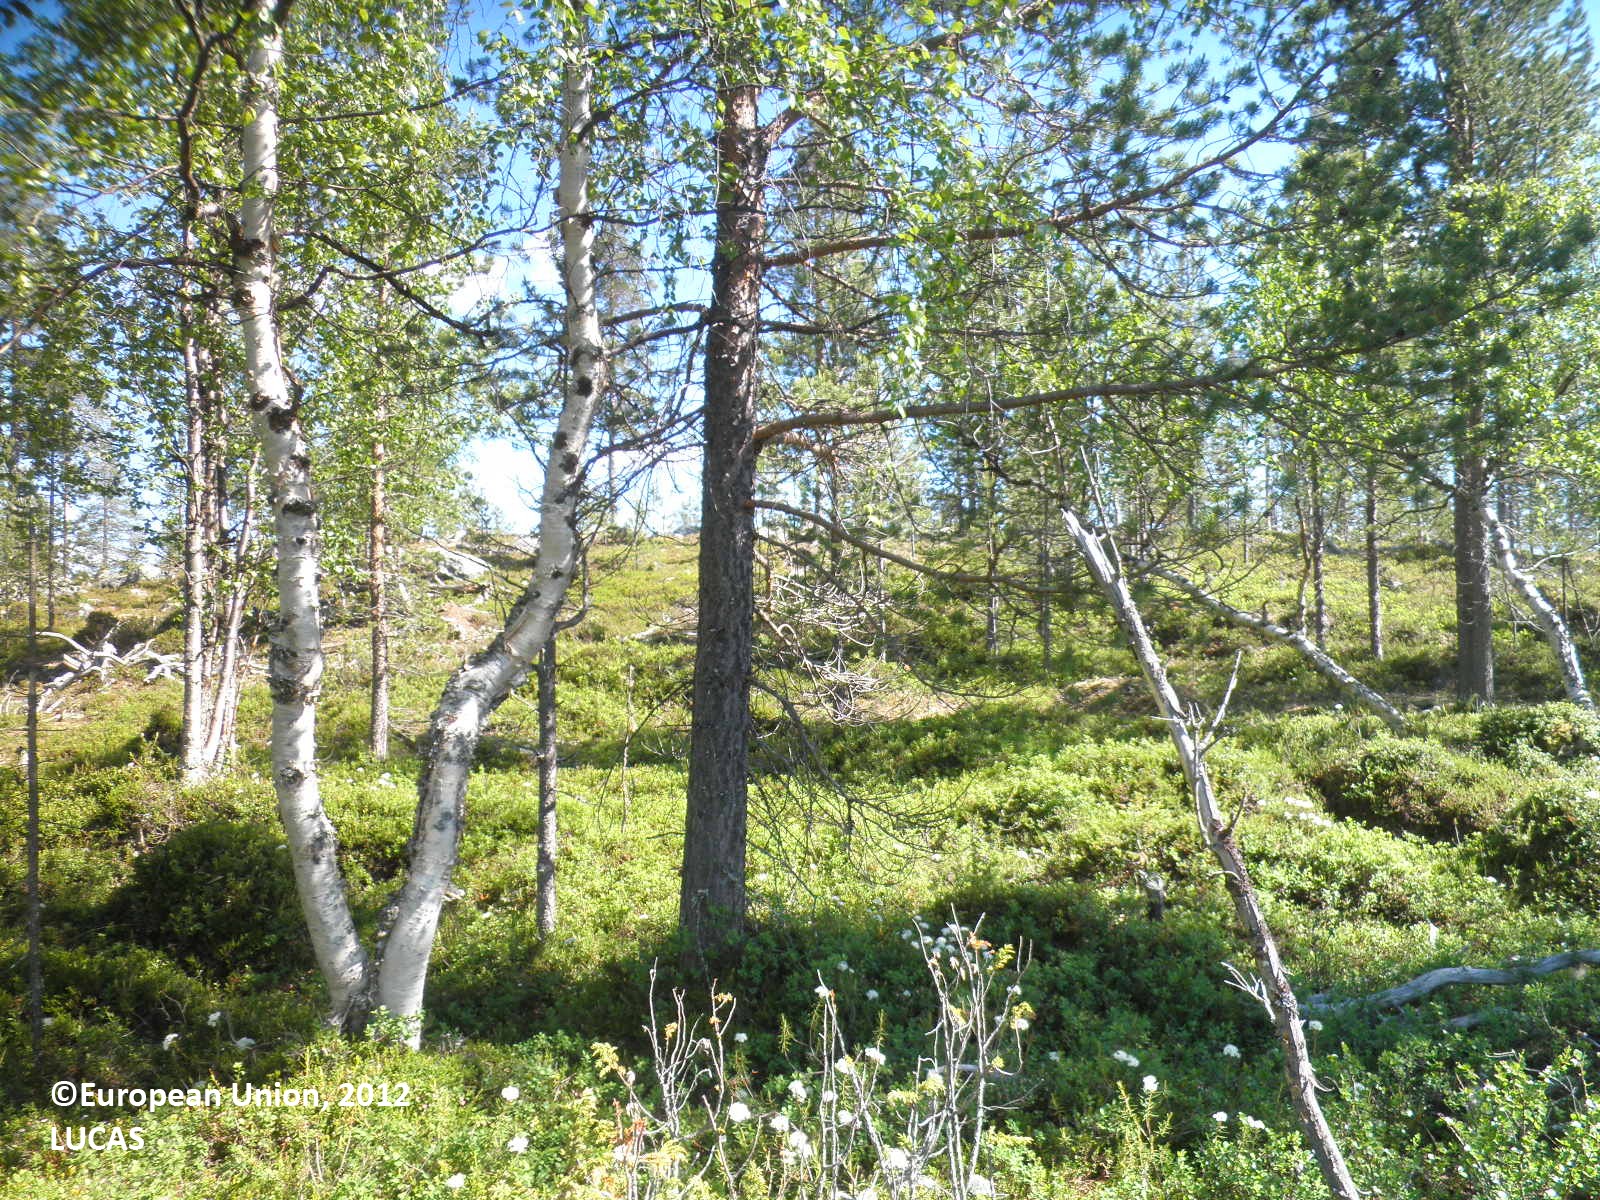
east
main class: Woodland
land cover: Pine dominated mixed woodland
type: boreal forest
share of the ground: 25 - 50 %
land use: Forestry
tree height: > 5 m
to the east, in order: Pine dominated mixed woodland; Pine dominated coniferous woodland
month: July
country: FI
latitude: 68.7884
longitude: 26.9251
